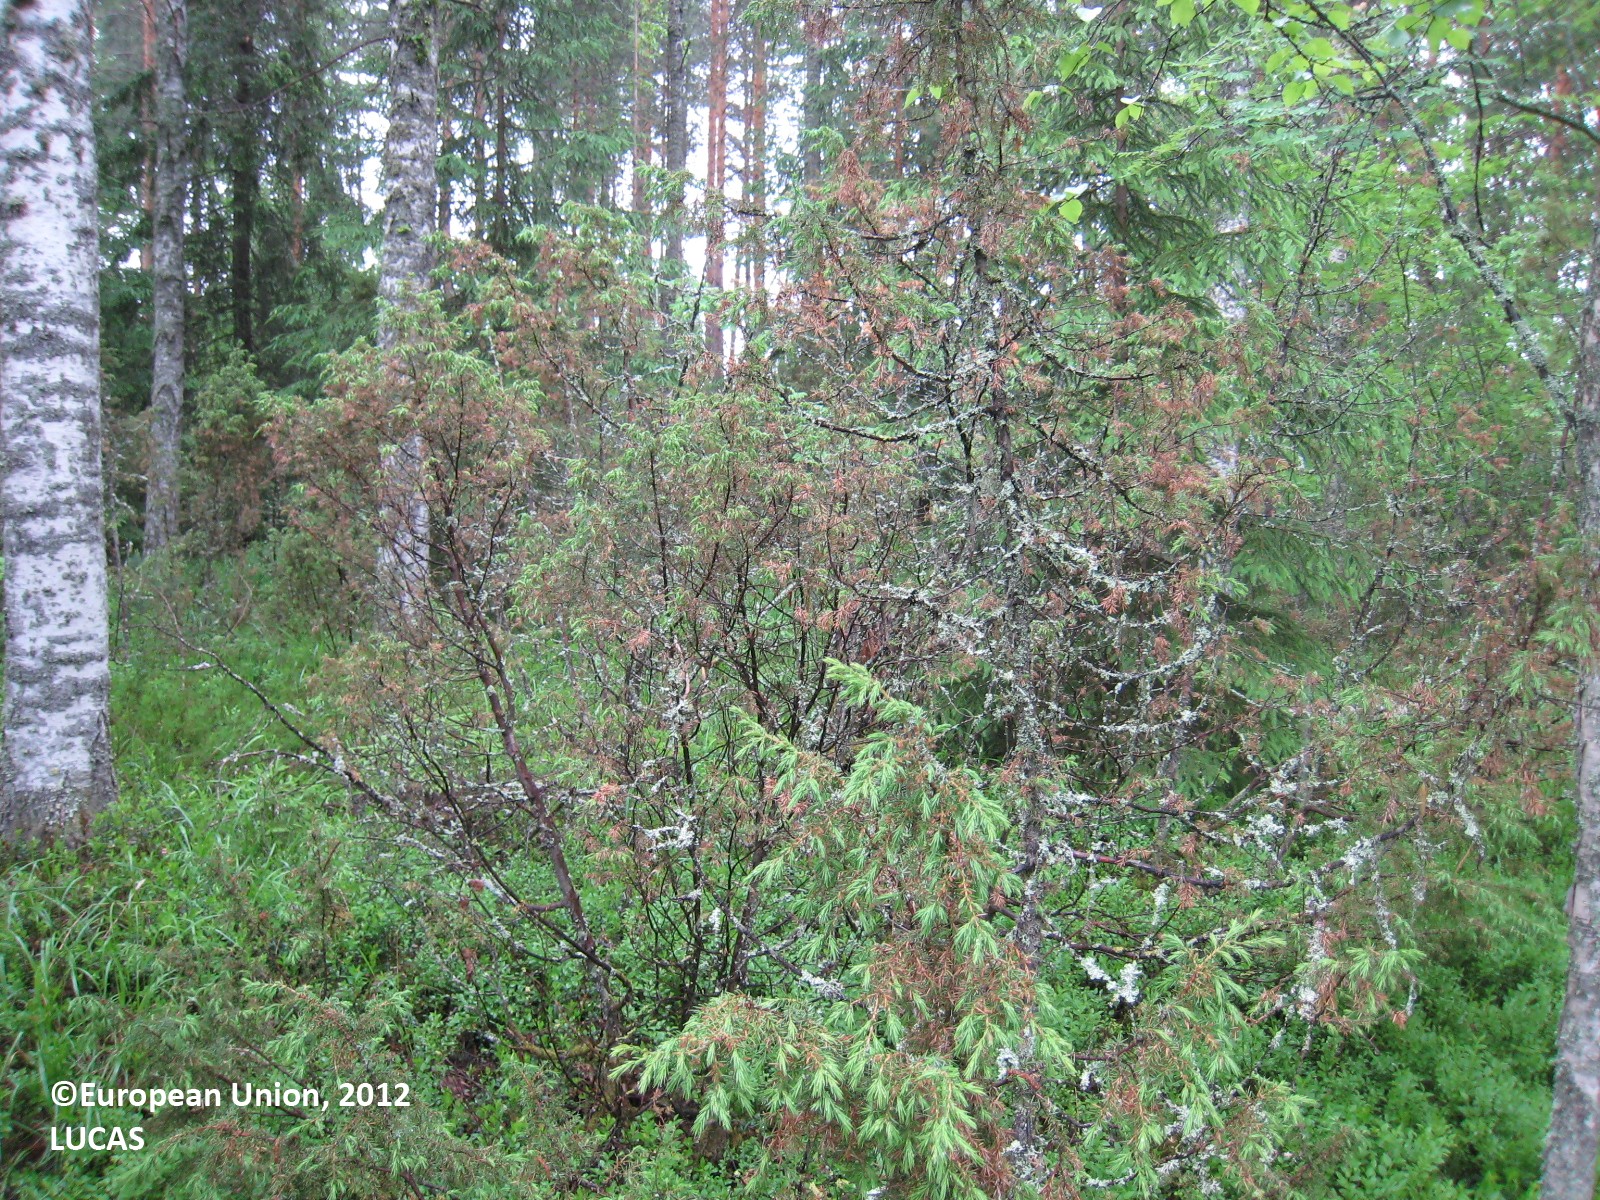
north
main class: Woodland
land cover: Pine dominated mixed woodland
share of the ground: 50 - 75 %
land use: Forestry
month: June
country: FI
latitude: 62.2972
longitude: 25.8763
